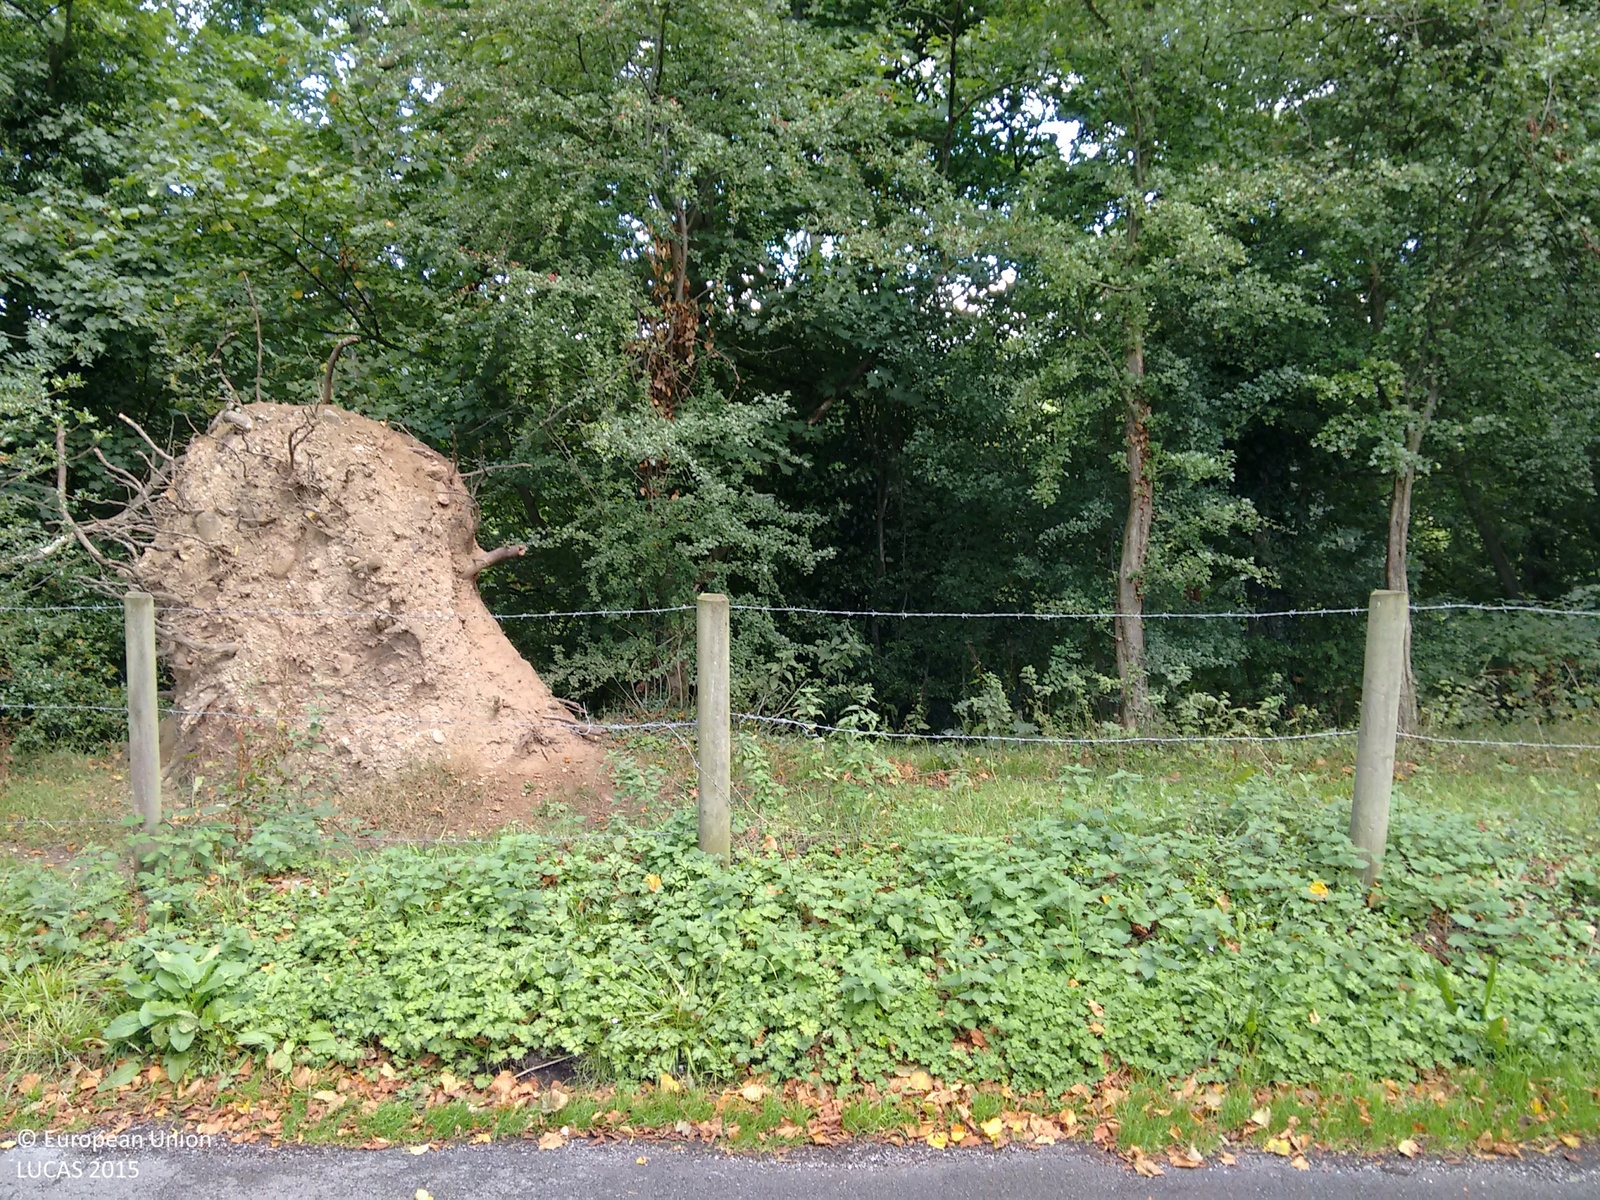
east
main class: Grassland
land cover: Grassland without tree/shrub cover
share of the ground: > 75 %
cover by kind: herbaceous plants 100 %
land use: Commerce
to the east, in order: Grassland without tree/shrub cover; Broadleaved woodland; Paved roads, cycling and walking lanes; Fences; Grassland without tree/shrub cover; Broadleaved woodland; Tracks; Broadleaved woodland; Rivers and streams; Broadleaved woodland; Grassland with sparse tree/shrub cover; Broadleaved woodland; Fences; Broadleaved woodland; Paved roads, cycling and walking lanes; Grass margins; Ditches and canals; Single bushes/trees; Fences; Managed hedges; Fences; Grassland without tree/shrub cover
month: September
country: GB
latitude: 53.1983
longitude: -3.0844
